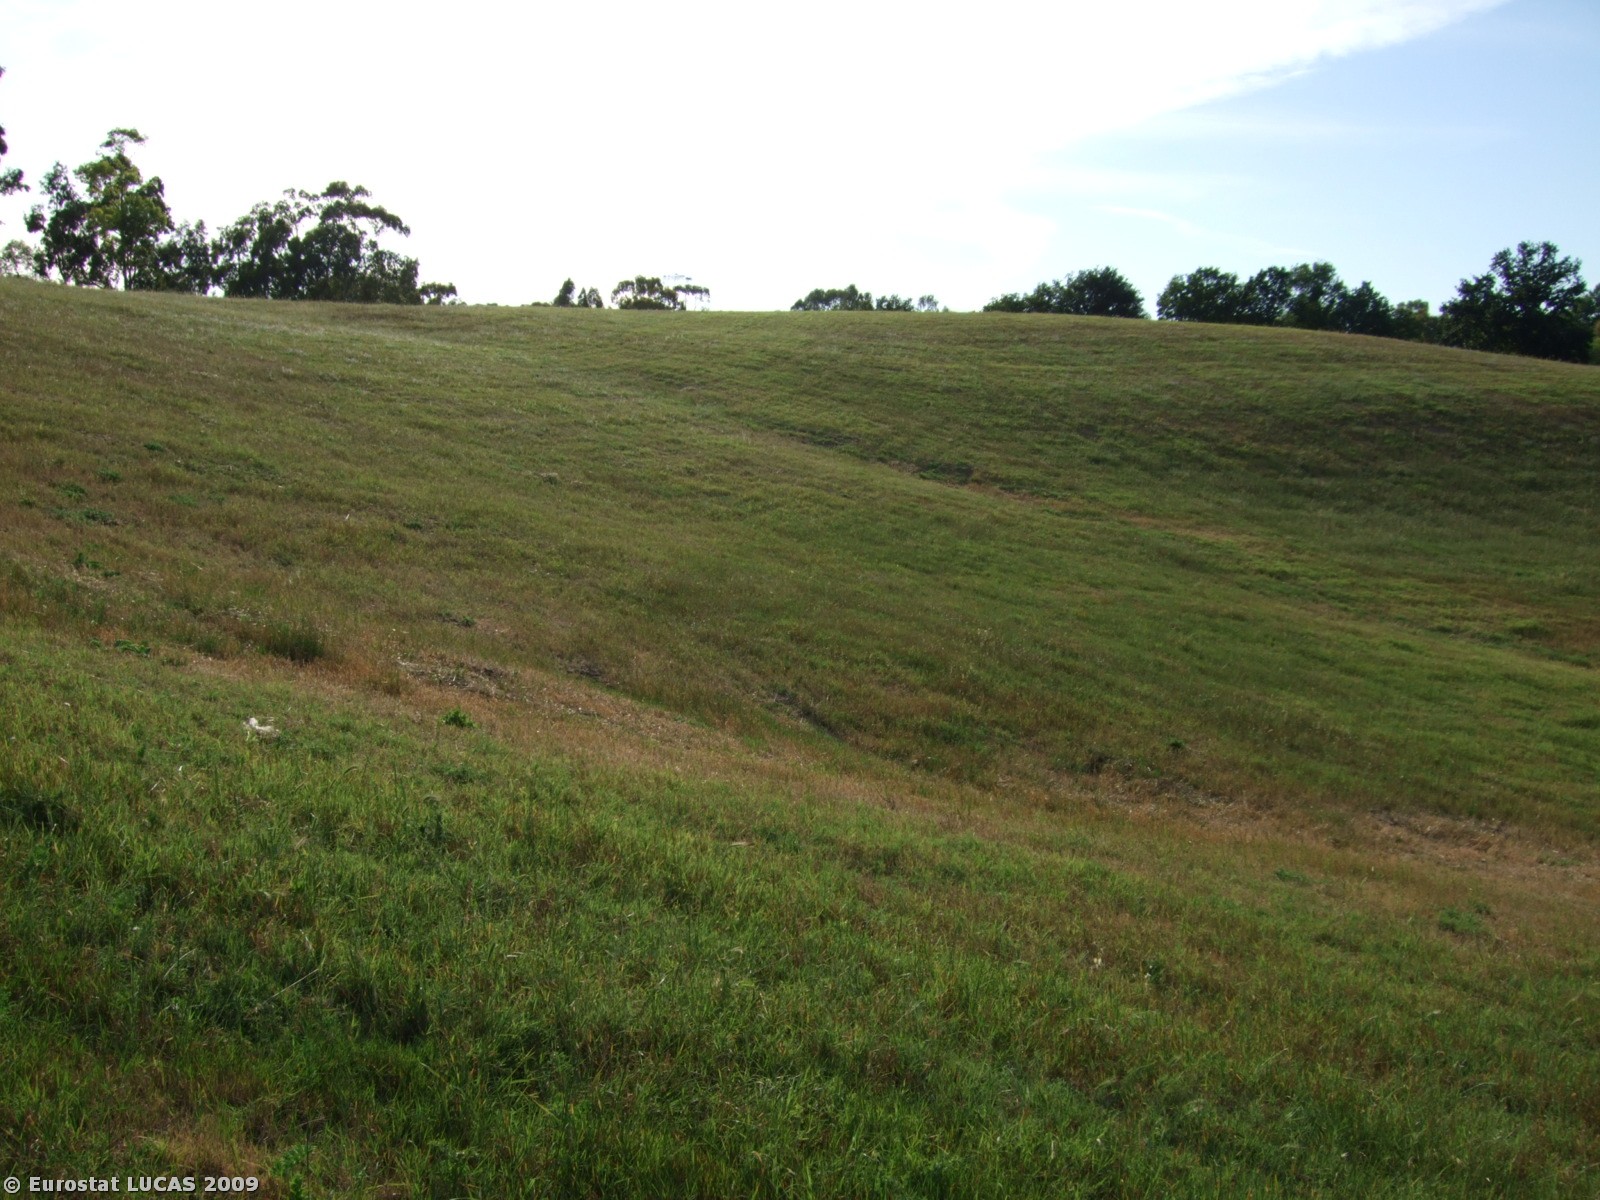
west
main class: Grassland
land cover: Grassland without tree/shrub cover
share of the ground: > 75 %
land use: Agriculture (excluding fallow land and kitchen gardens)
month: June
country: IT
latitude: 41.9402
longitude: 12.3432
